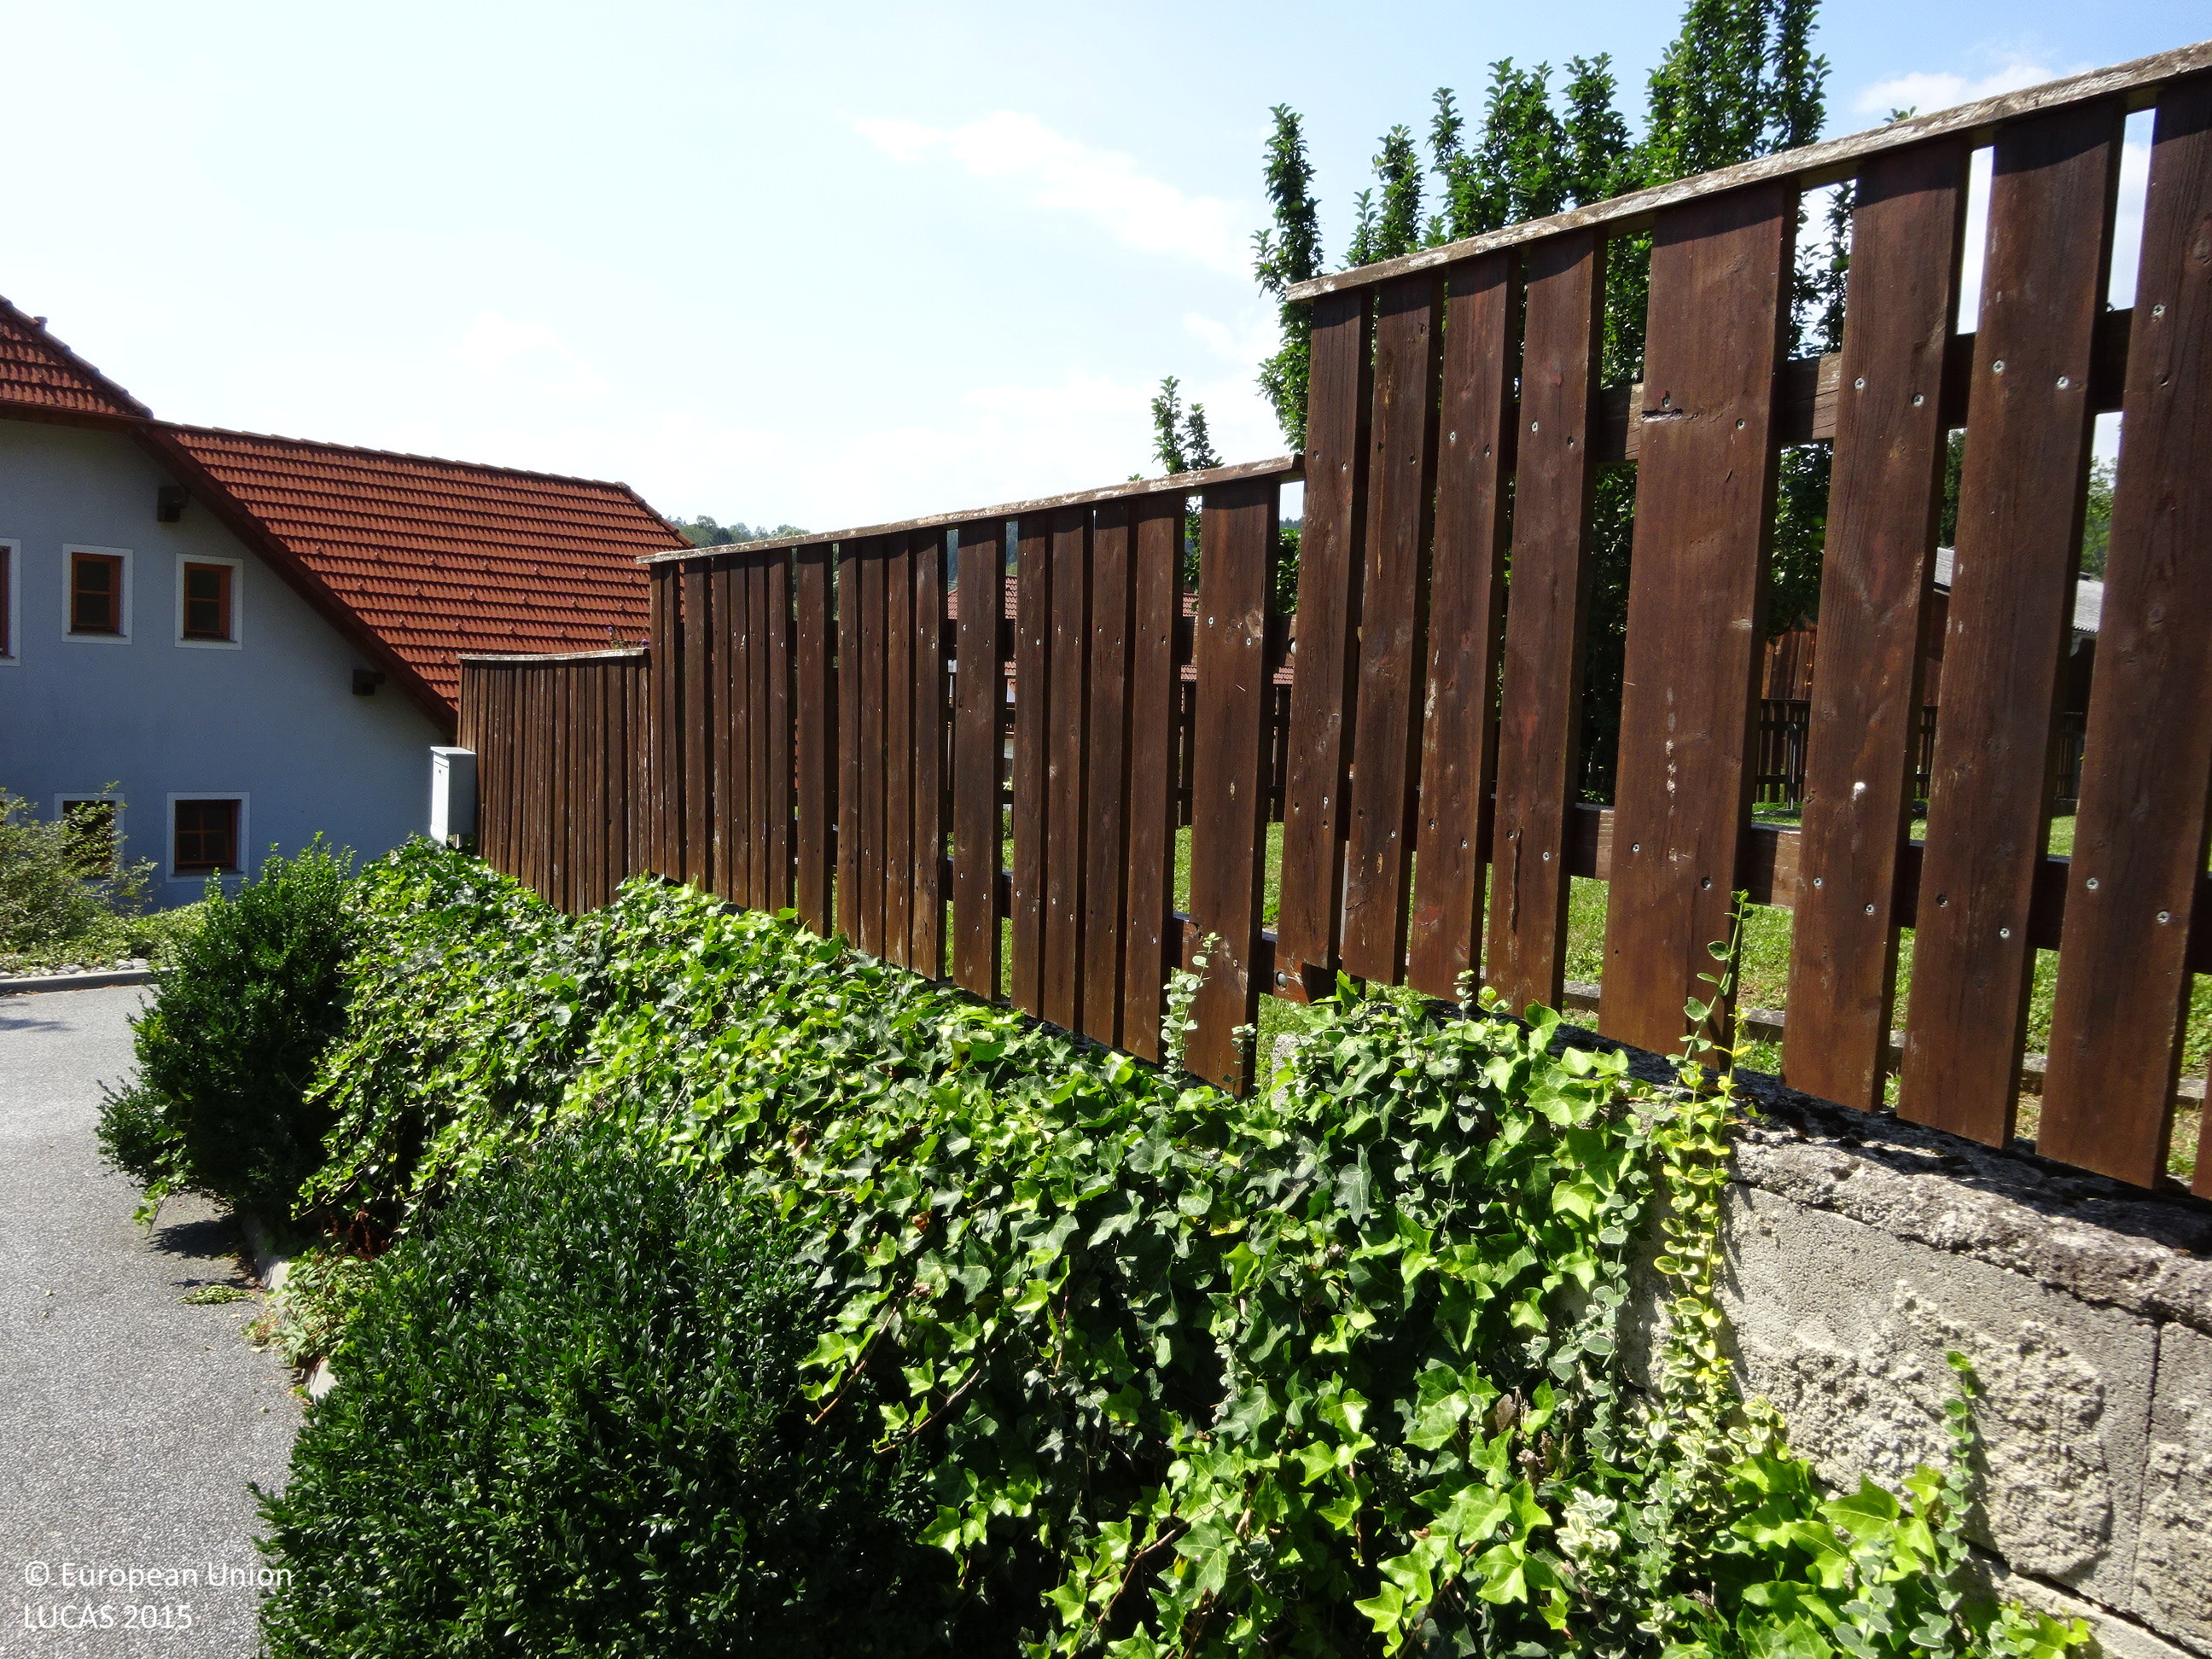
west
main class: Grassland
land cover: Grassland with sparse tree/shrub cover
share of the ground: 25 - 50 %
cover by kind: herbaceous plants 55 %, consolidated bare surface 40 %, broadleaved forest trees 5 %
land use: Residential
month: August
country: AT
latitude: 47.4266
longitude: 16.0340
